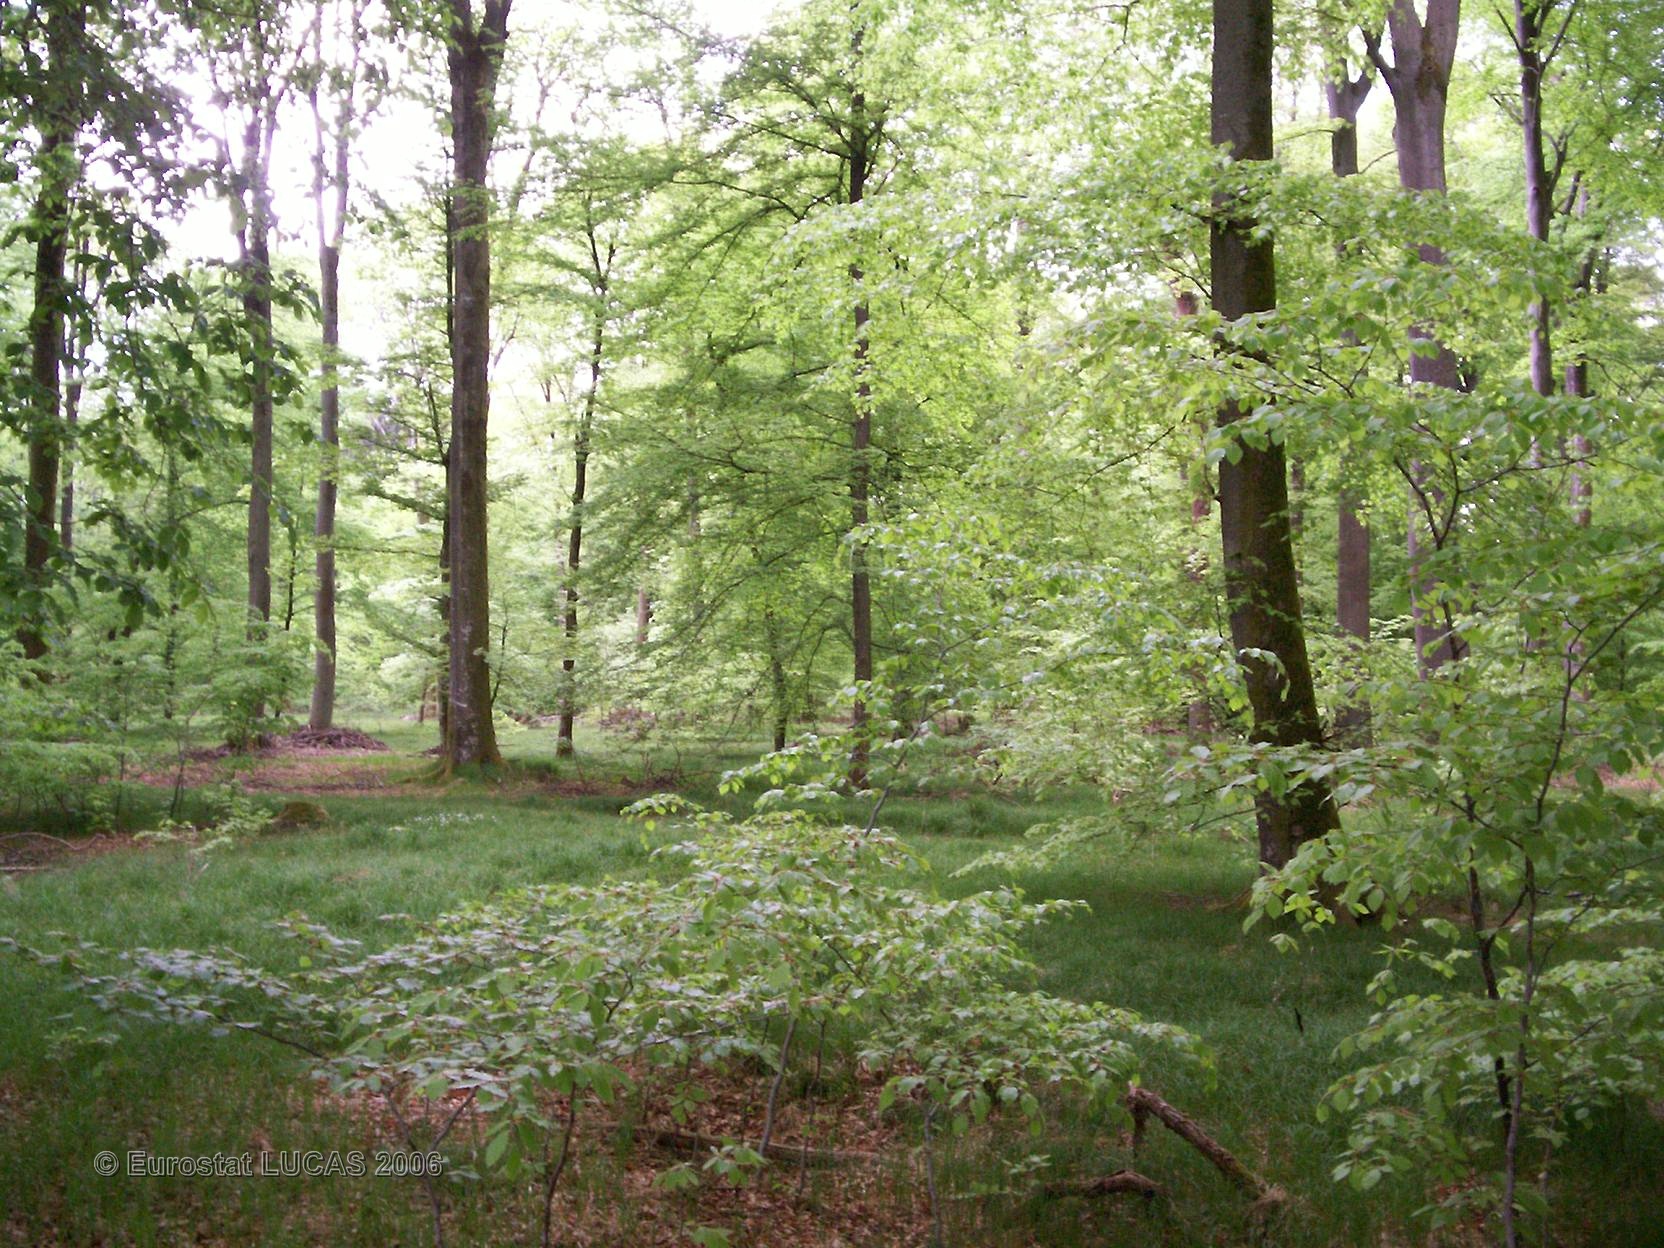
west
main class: Woodland
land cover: Broadleaved forest
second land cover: Grassland with sparse tree/shrub cover
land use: Forestry
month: May
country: FR
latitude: 47.7354
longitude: 7.1078
